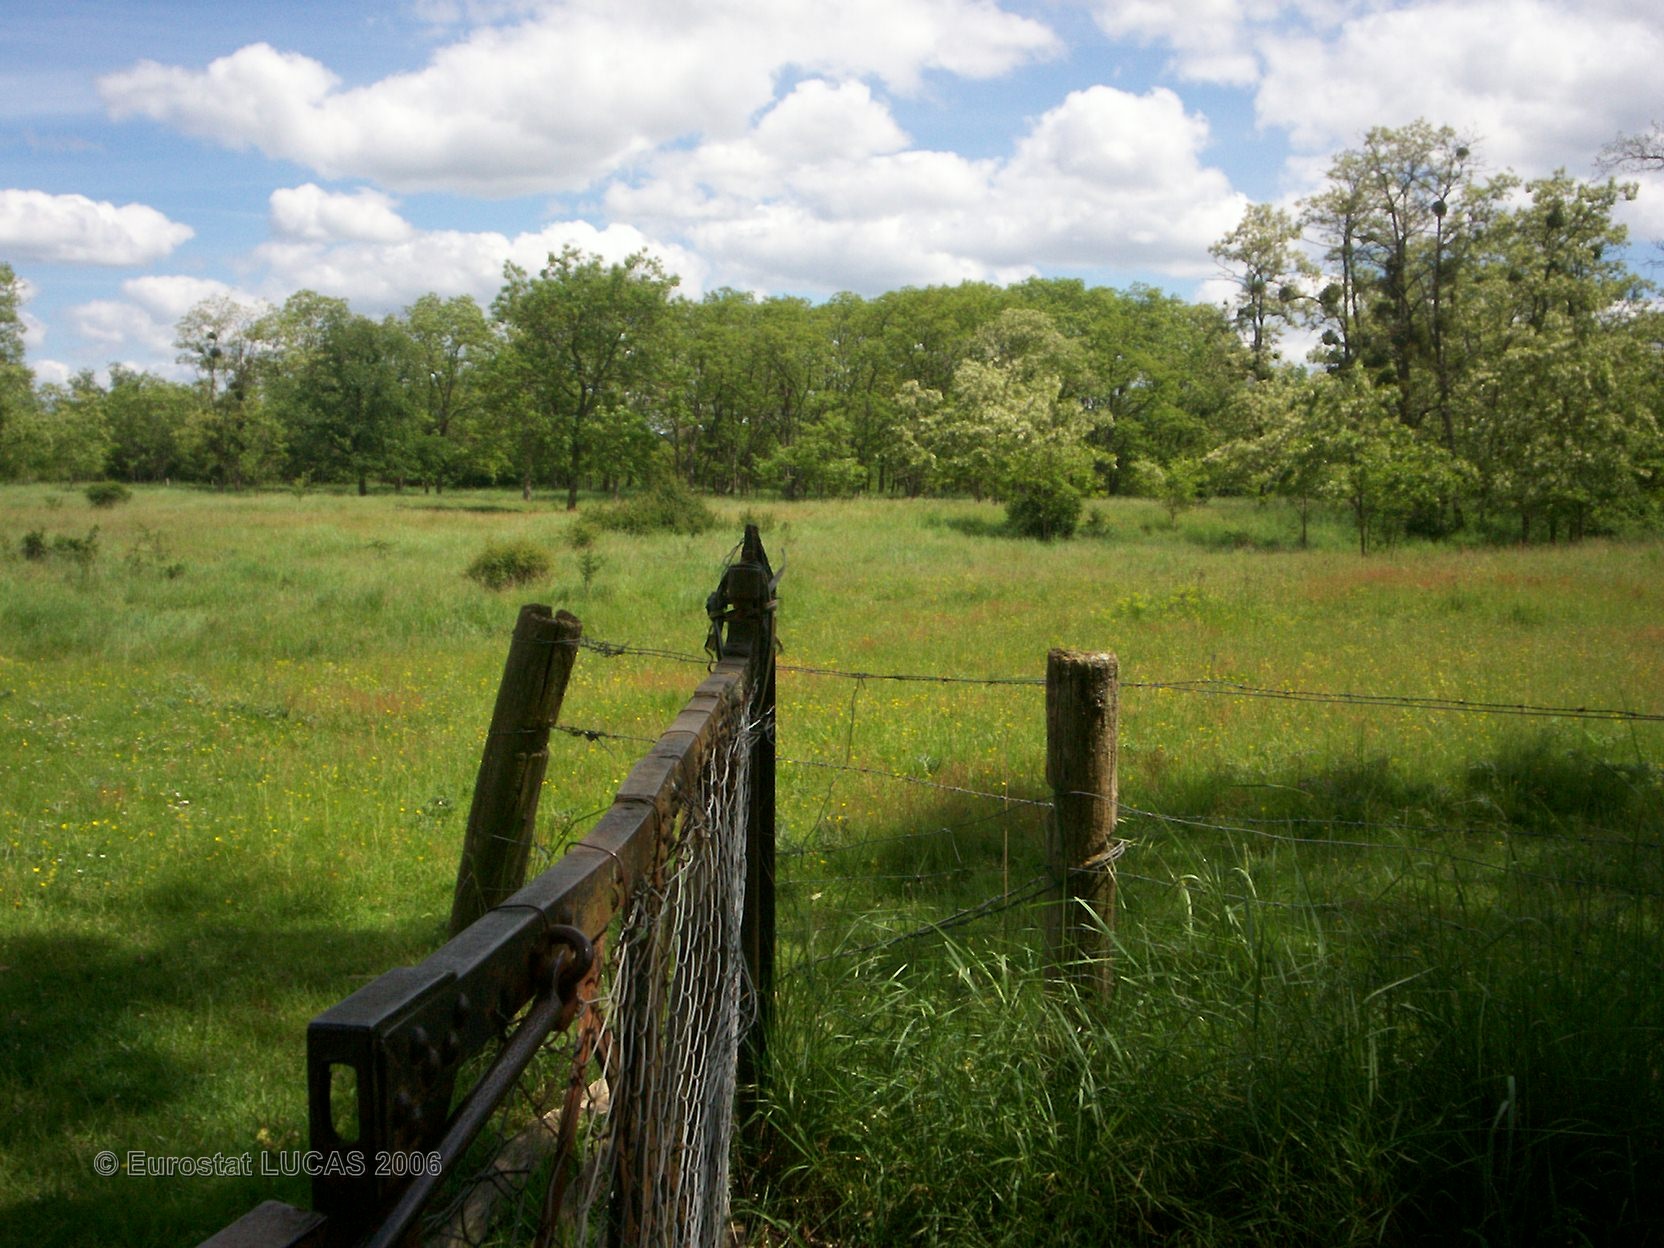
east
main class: Grassland
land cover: Grassland without tree/shrub cover
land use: Agriculture (excluding fallow land and kitchen gardens)
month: May
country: FR
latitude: 47.0473
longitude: 3.0590
